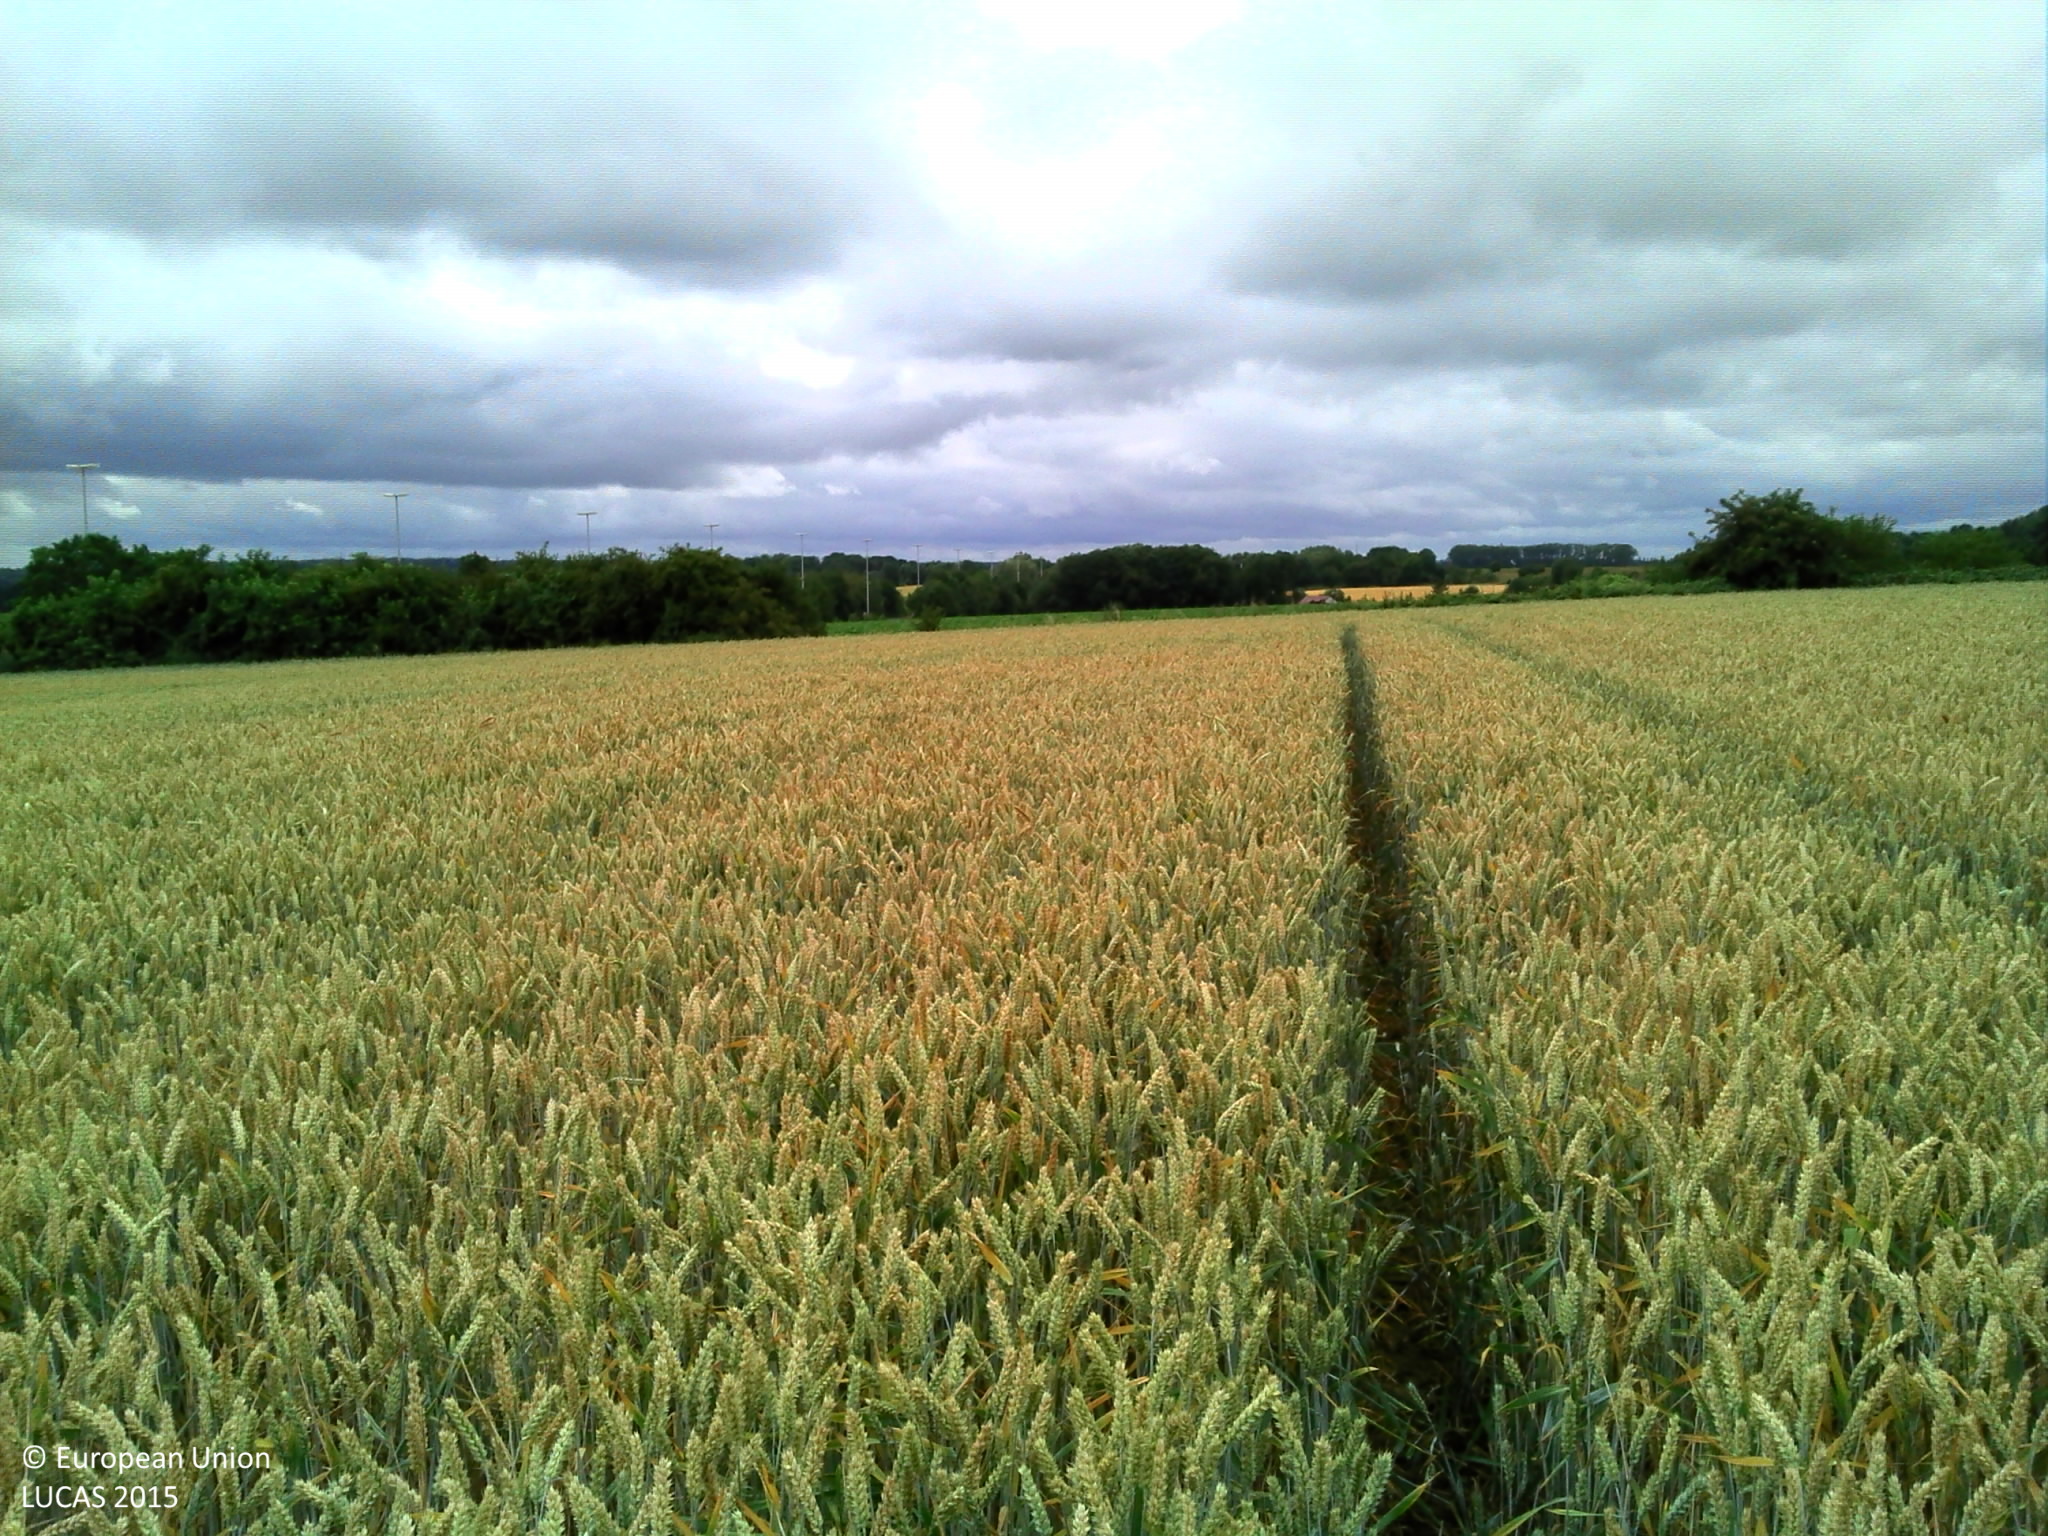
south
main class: Cropland
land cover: Common wheat
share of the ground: > 75 %
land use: Agriculture (excluding fallow land and kitchen gardens)
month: July
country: BE
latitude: 50.3205
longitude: 4.1098
